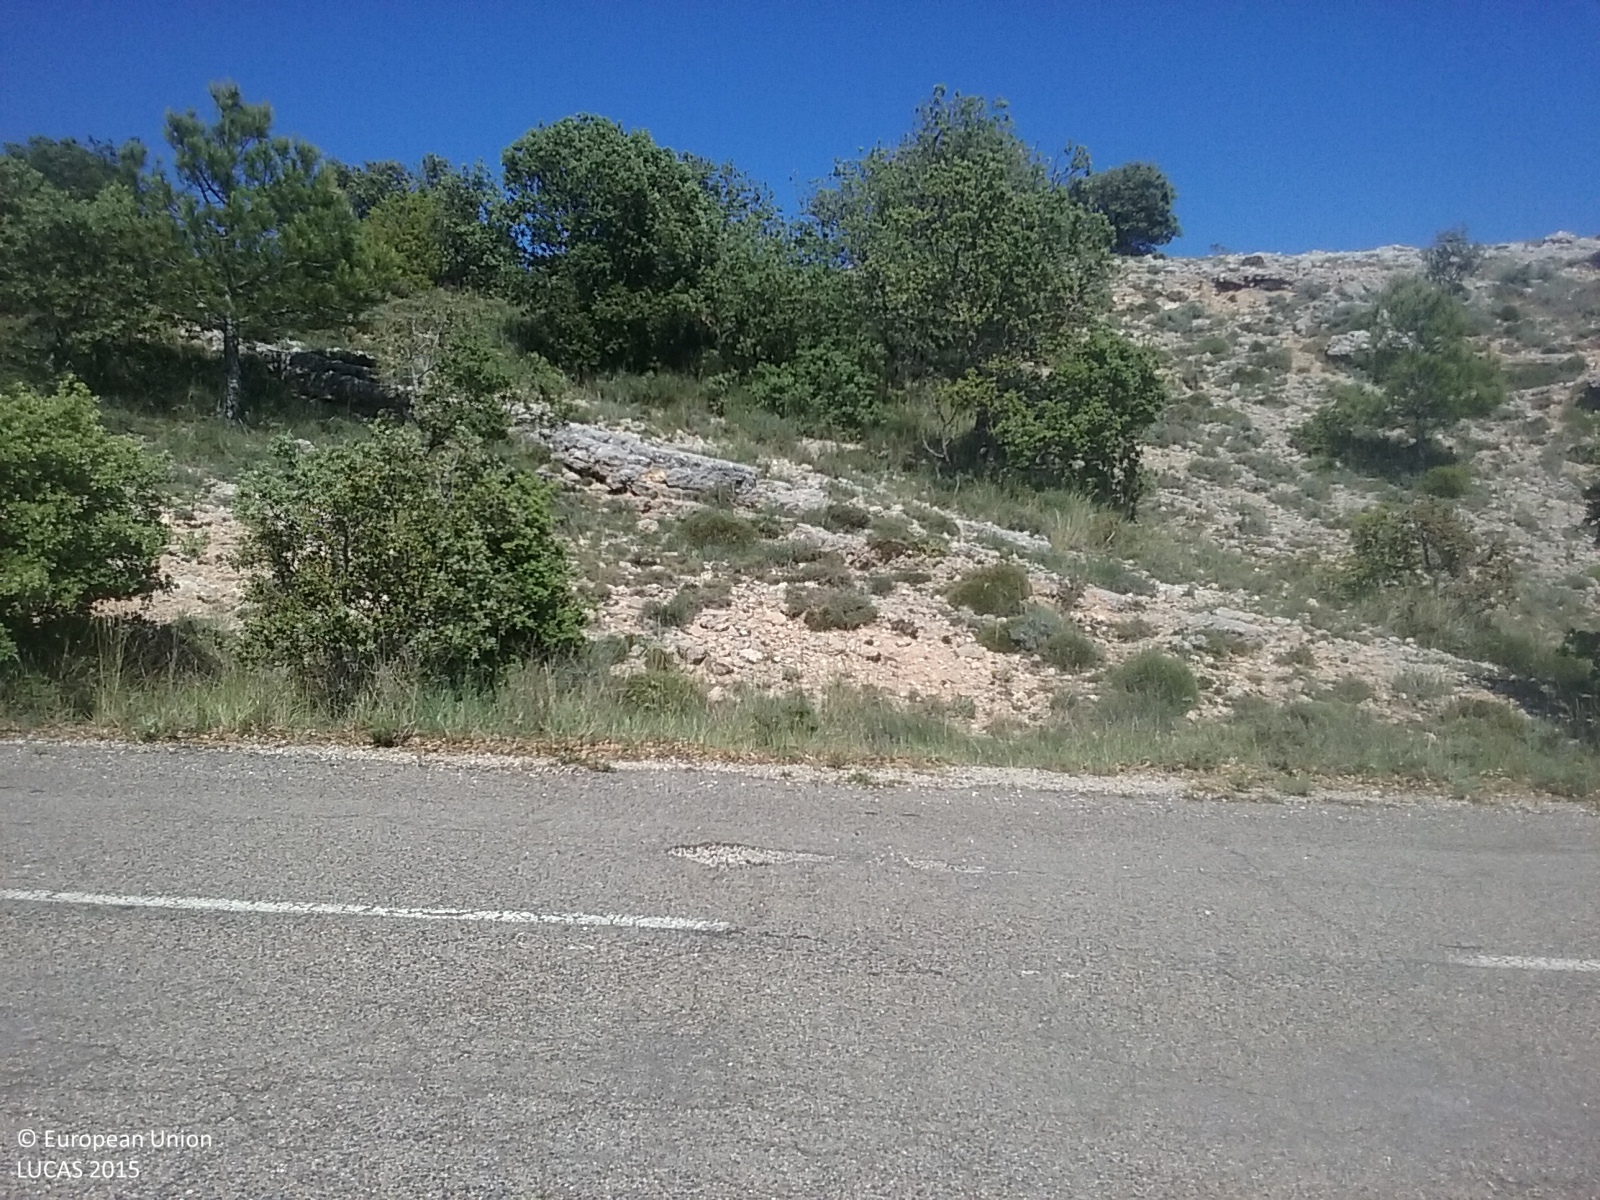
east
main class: Woodland
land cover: Broadleaved woodland
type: broadleaved evergreen forest
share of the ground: 50 - 75 %
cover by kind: broadleaved forest trees 60 %, shrubs 20 %, herbaceous plants 10 %, unconsolidated bare surface 10 %
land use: Forestry
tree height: < 5 m
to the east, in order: Broadleaved woodland; Fences; Shrubland with sparse tree cover; Paved roads, cycling and walking lanes; Shrubland with sparse tree cover; Shrubland without tree cover
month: June
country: ES
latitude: 40.6584
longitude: -0.0728
